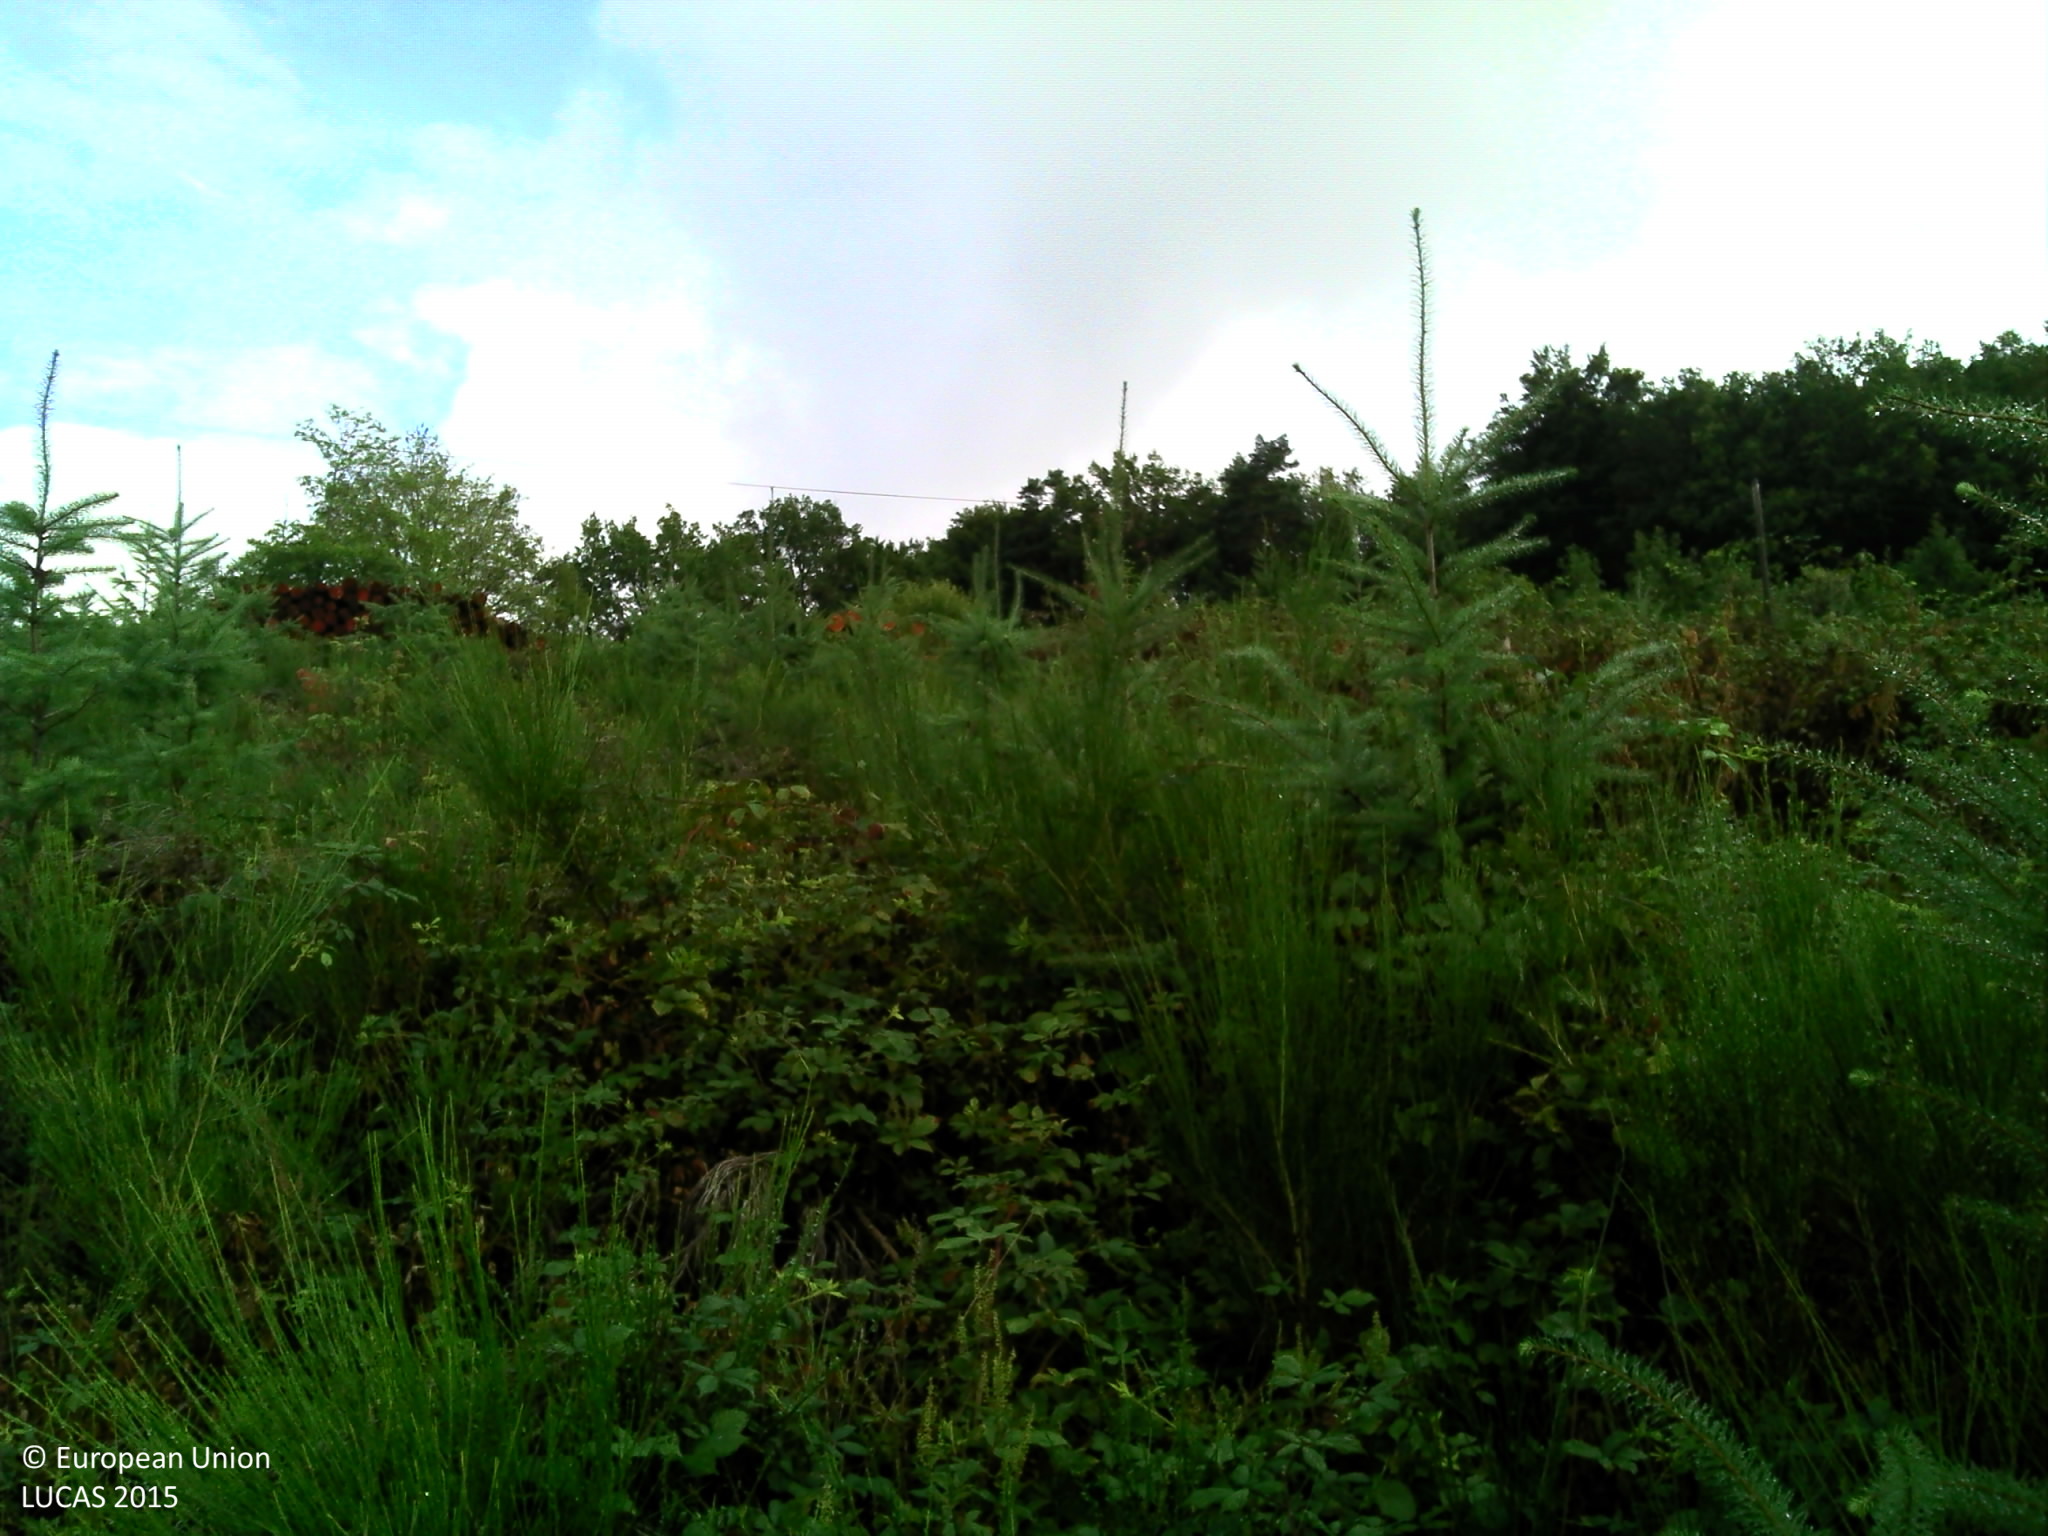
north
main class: Shrubland
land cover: Shrubland with sparse tree cover
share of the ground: > 75 %
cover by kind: shrubs 95 %, coniferous forest trees 5 %
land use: Semi-natural and natural areas not in use
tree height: < 5 m
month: August
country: FR
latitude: 45.4943
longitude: 1.8185
